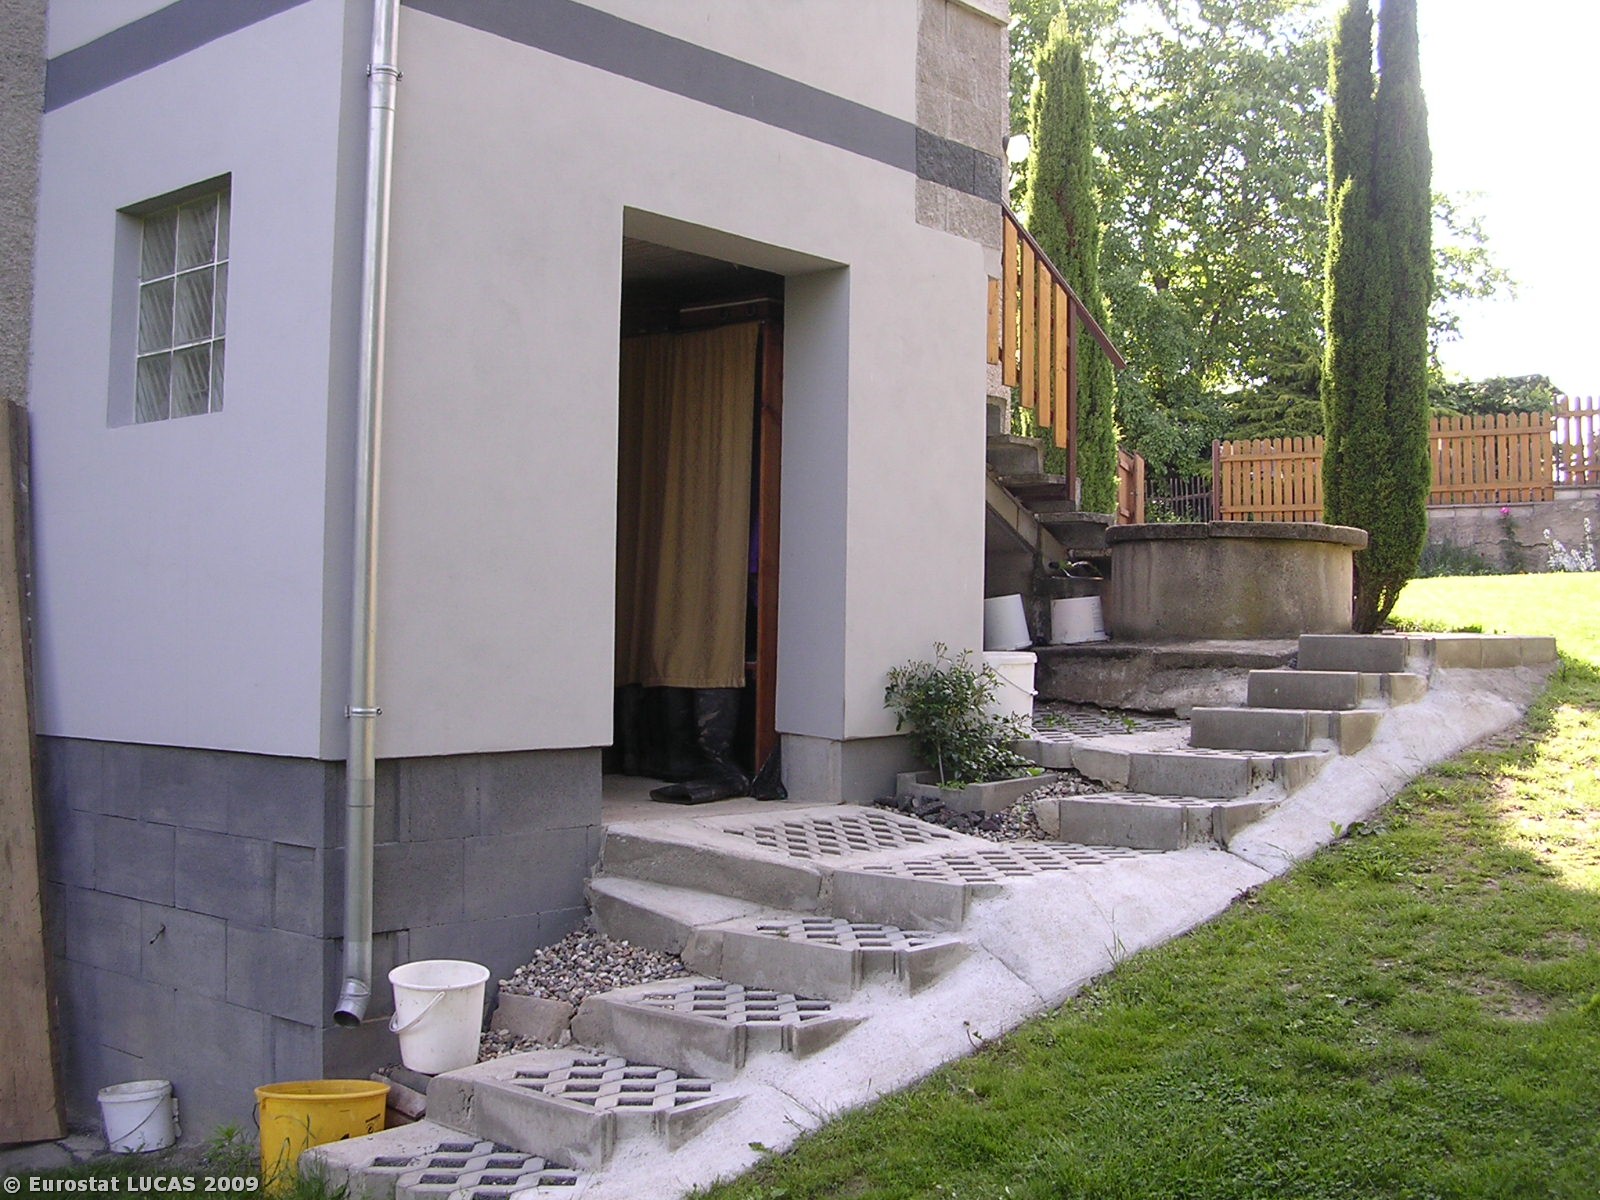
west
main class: Grassland
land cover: Grassland with sparse tree/shrub cover
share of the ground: > 75 %
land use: Residential
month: June
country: CZ
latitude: 50.5552
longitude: 14.2499
